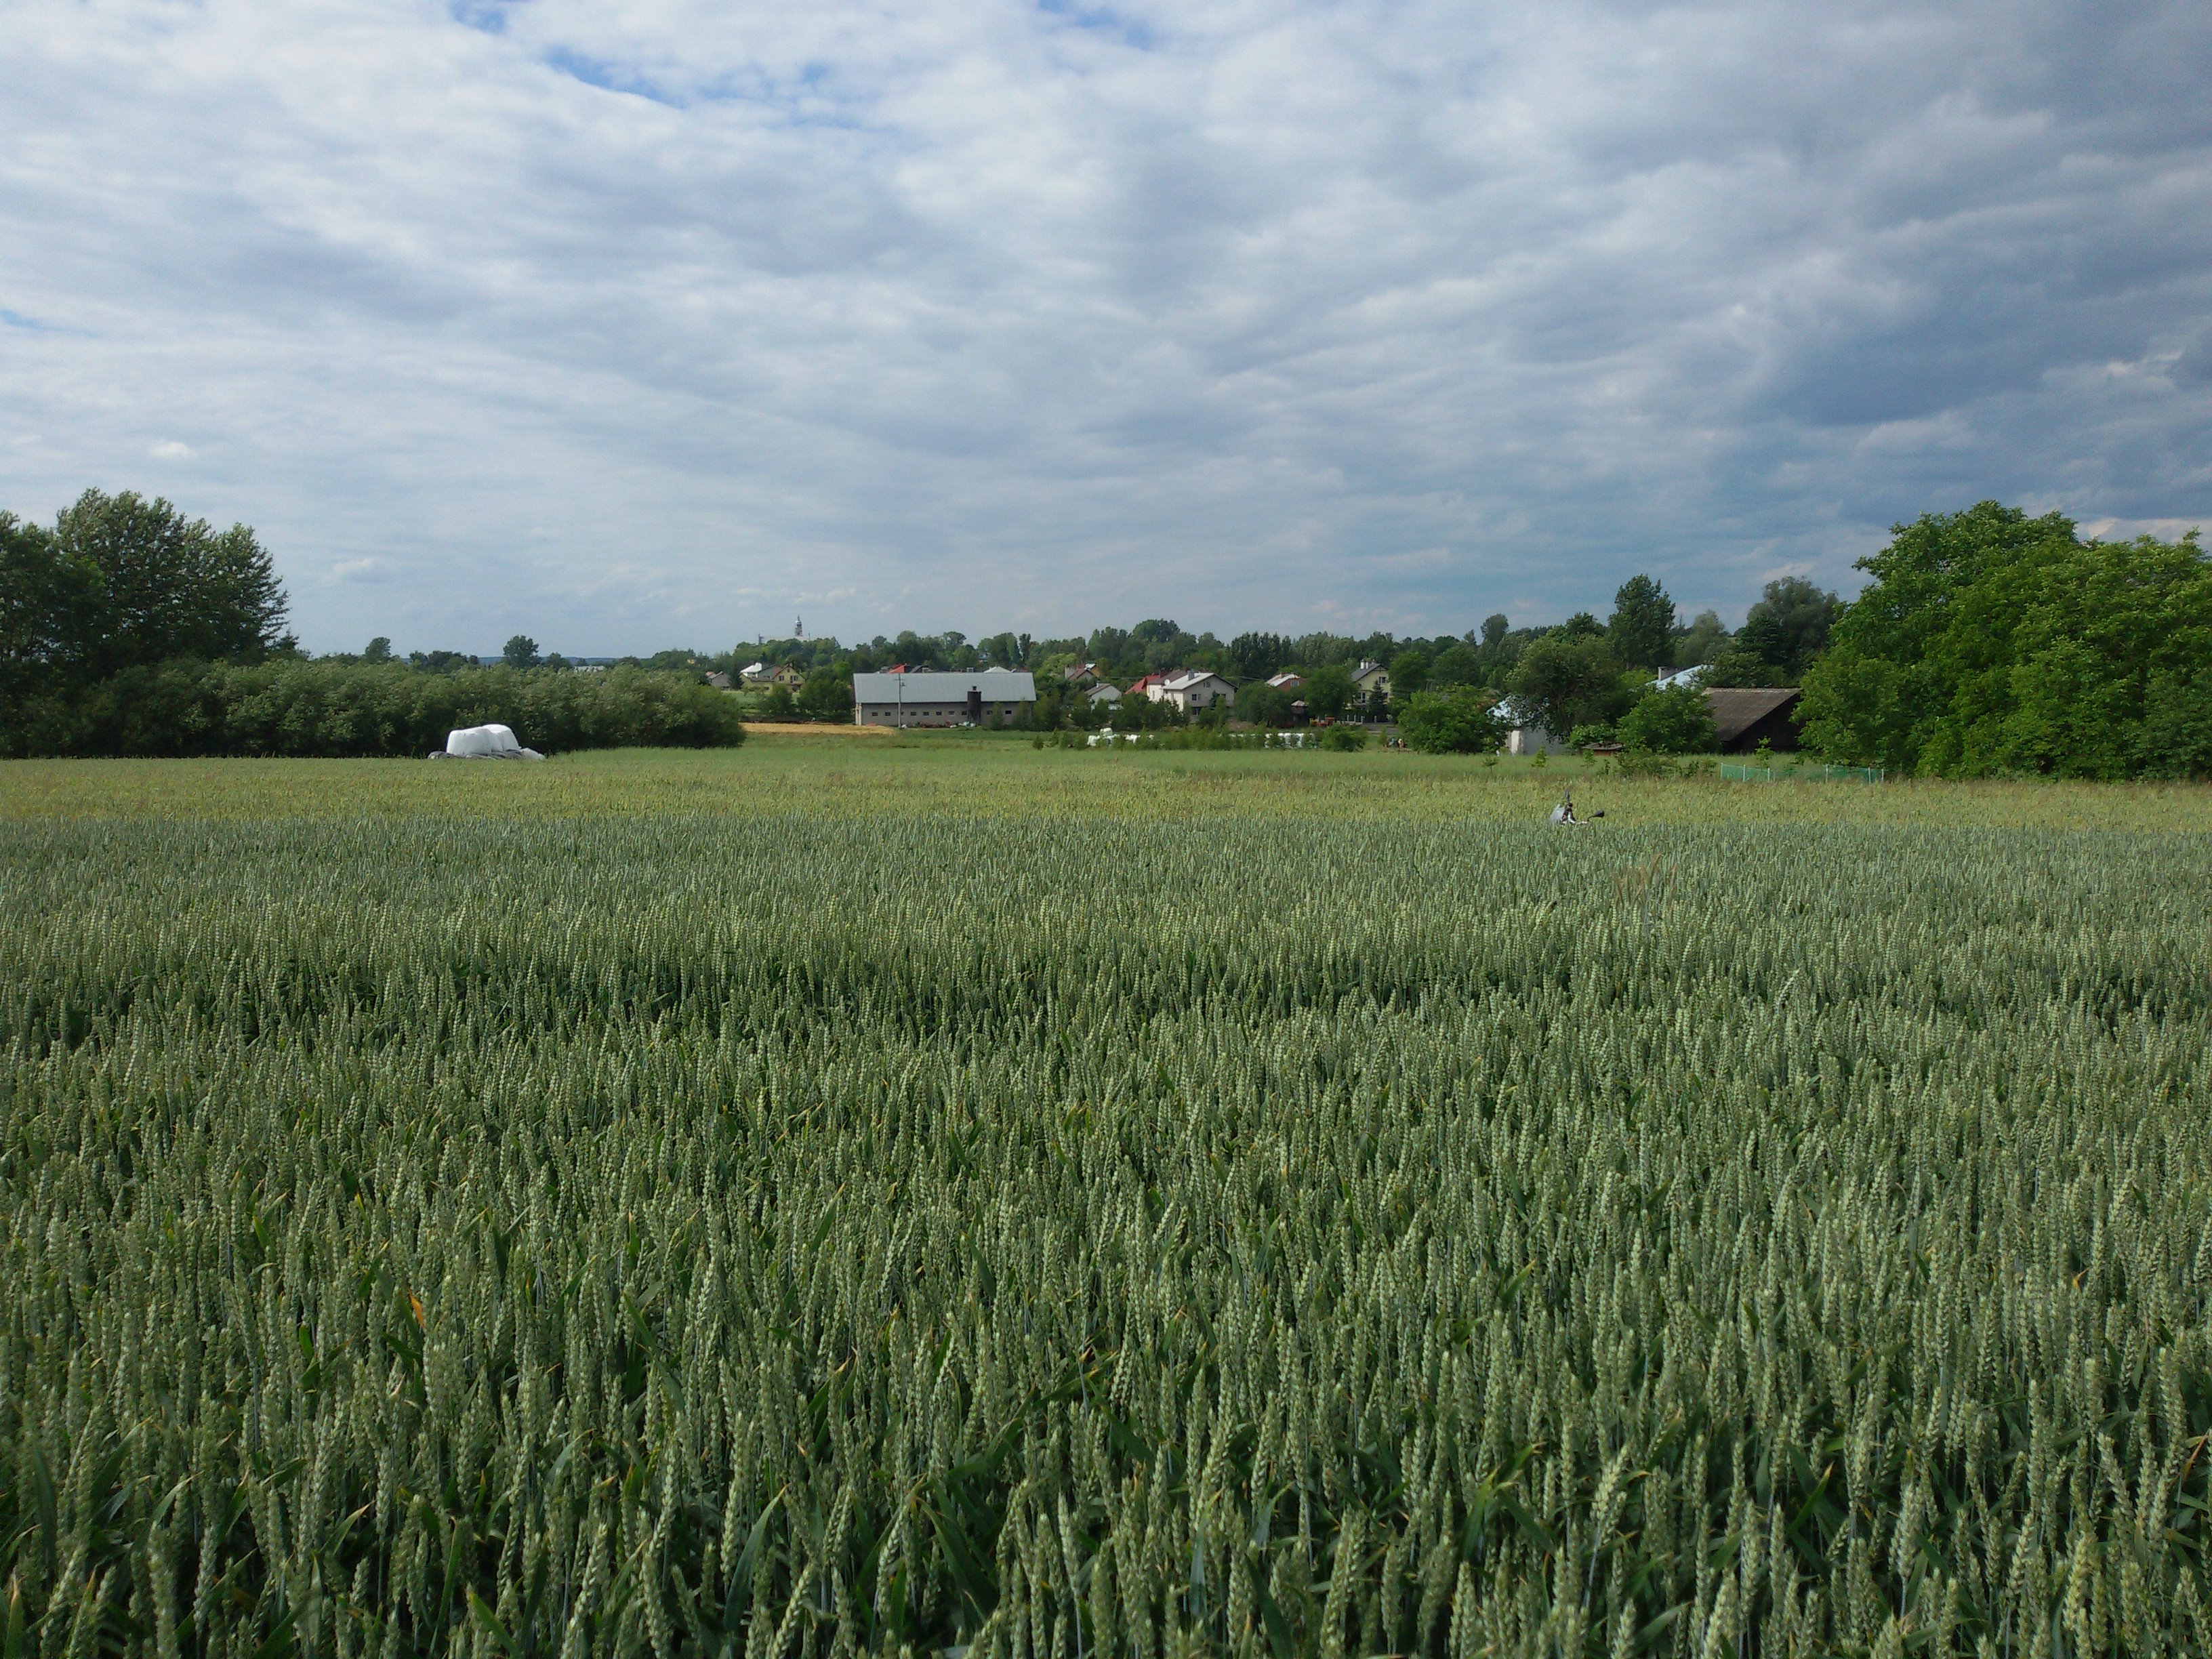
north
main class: Cropland
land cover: Common wheat
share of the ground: > 75 %
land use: Agriculture (excluding fallow land and kitchen gardens)
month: June
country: PL
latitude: 50.0566
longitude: 22.3402
